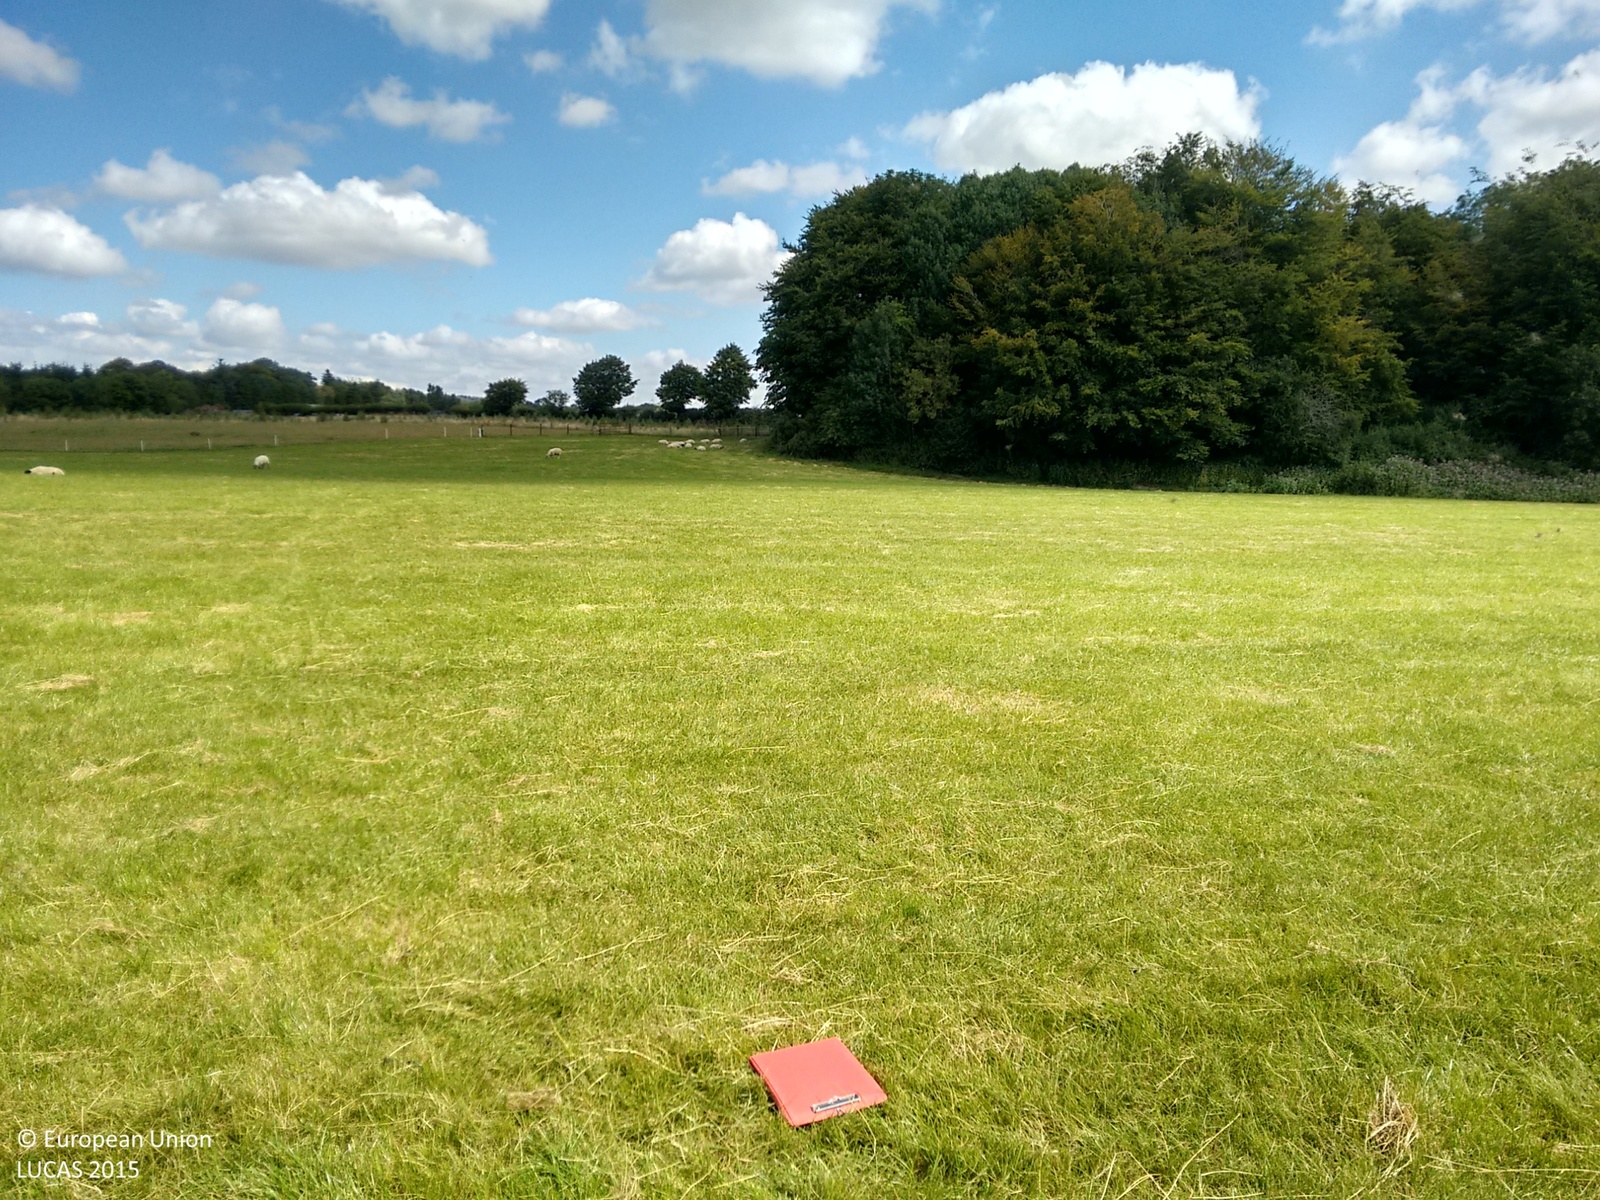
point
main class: Grassland
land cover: Grassland without tree/shrub cover
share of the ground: > 75 %
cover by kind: herbaceous plants 100 %
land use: Agriculture (excluding fallow land and kitchen gardens)
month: August
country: IE
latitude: 52.6123
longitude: -6.5974
